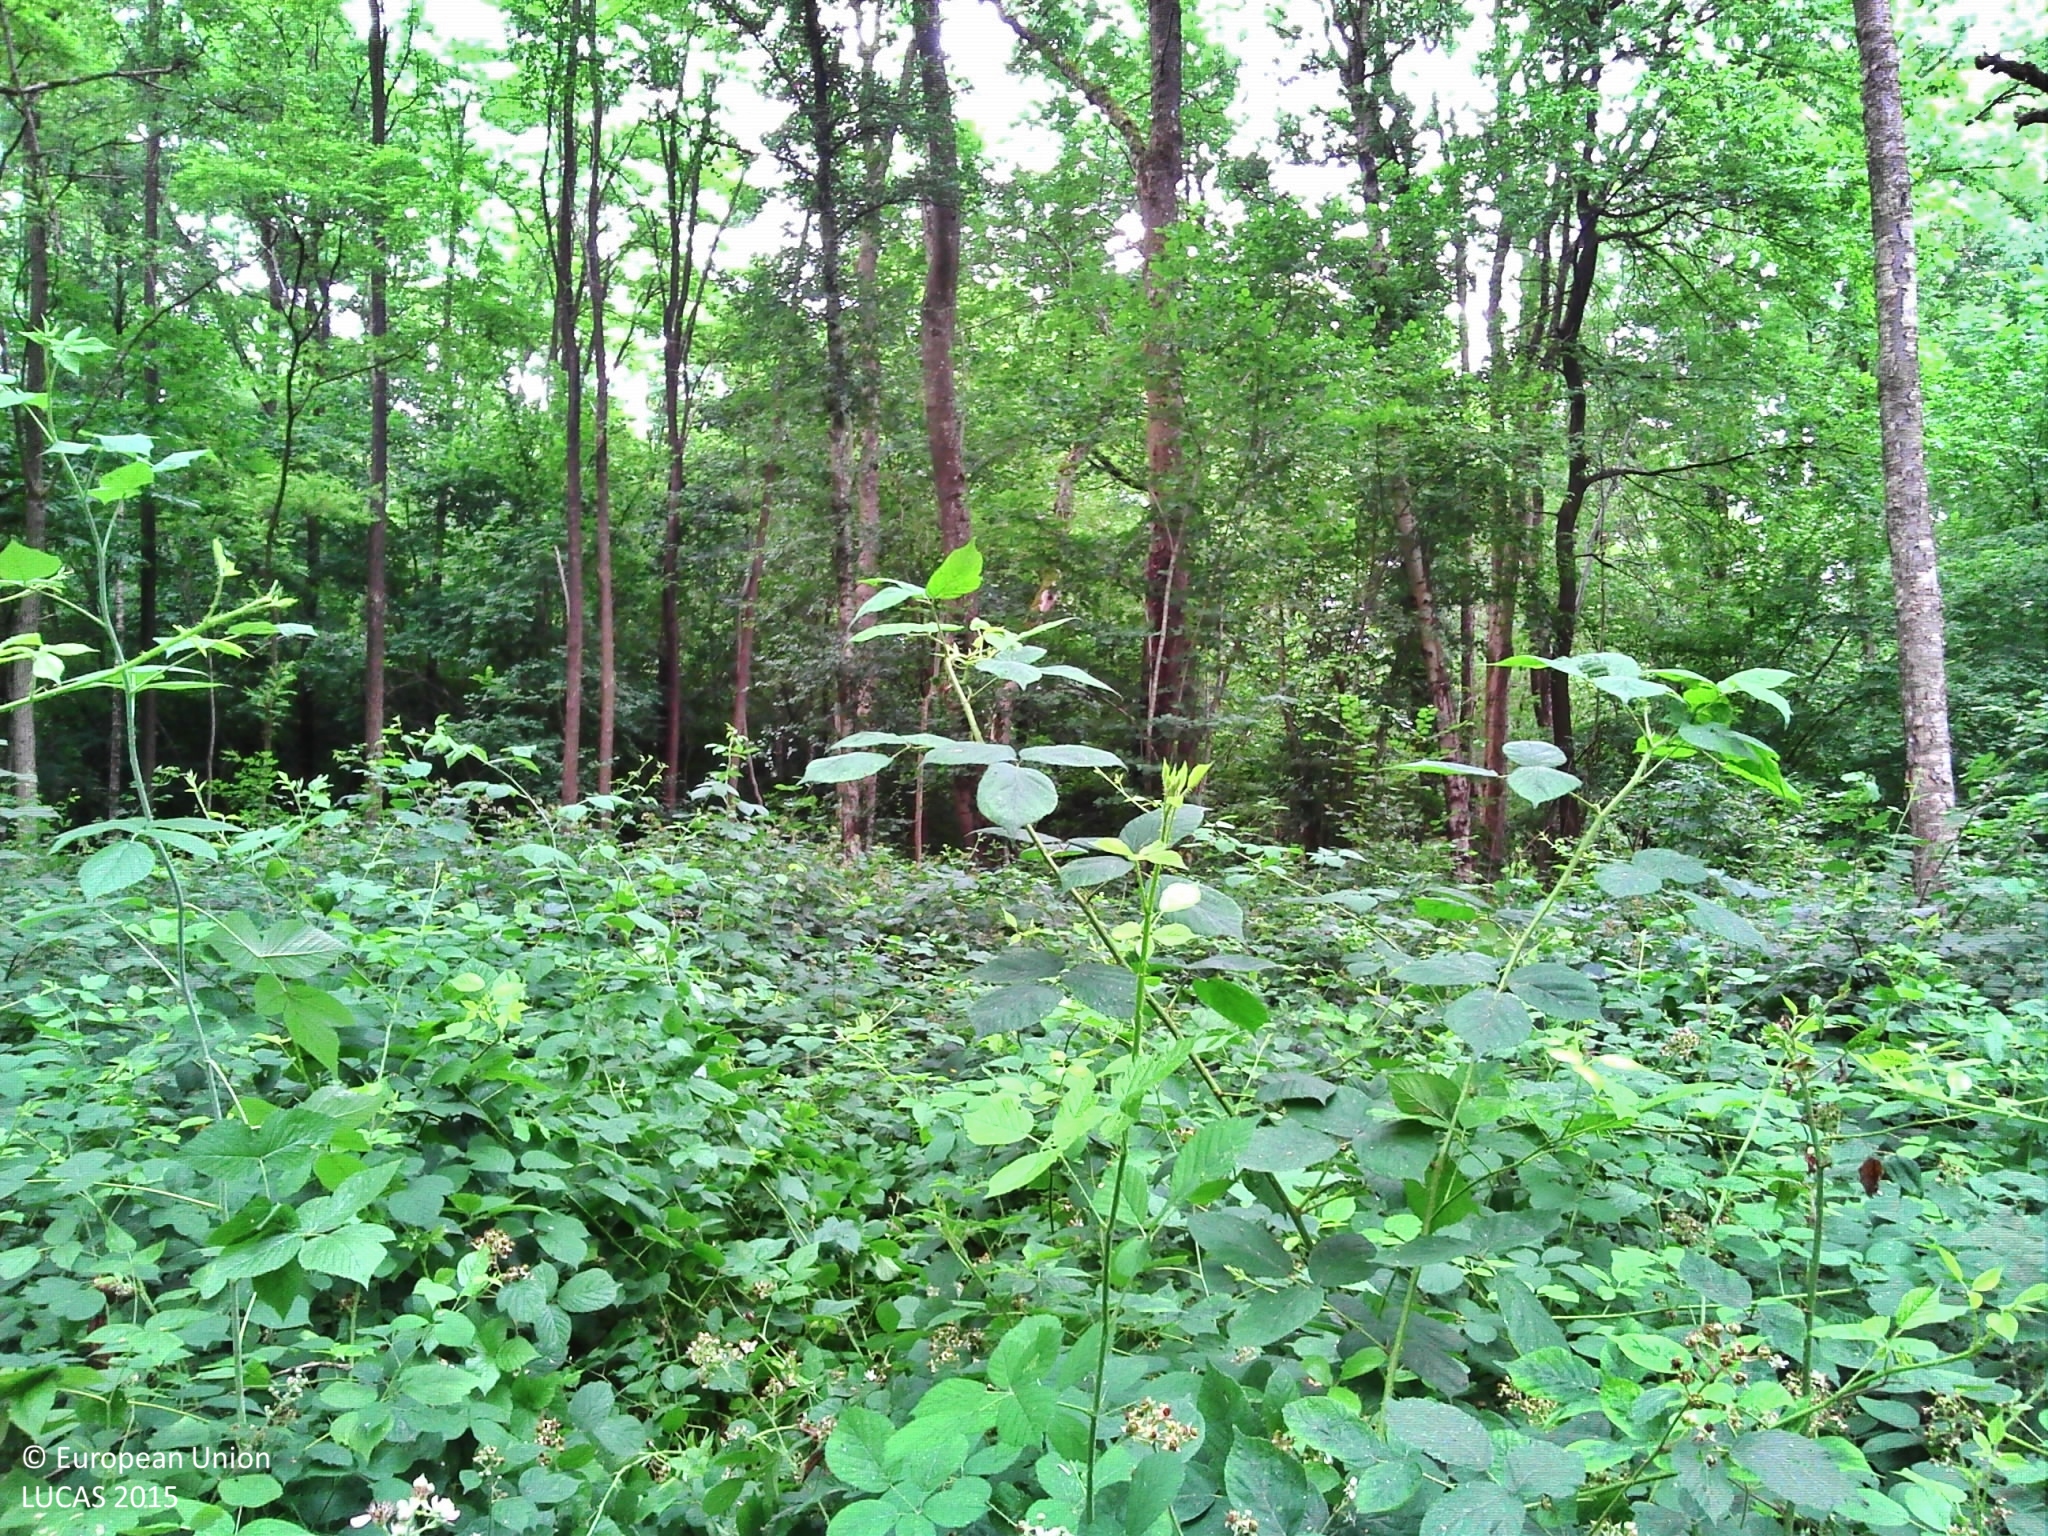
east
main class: Woodland
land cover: Broadleaved woodland
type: mesophytic deciduous forest
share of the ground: > 75 %
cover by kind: broadleaved forest trees 70 %, shrubs 15 %, herbaceous plants 15 %
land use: Forestry
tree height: > 5 m
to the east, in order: Broadleaved woodland; Tracks; Broadleaved woodland; Grass margins; Paved roads, cycling and walking lanes; Grass margins; Electric lines; Broadleaved woodland; Groves; Common wheat
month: July
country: FR
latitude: 49.3835
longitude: 1.8152
